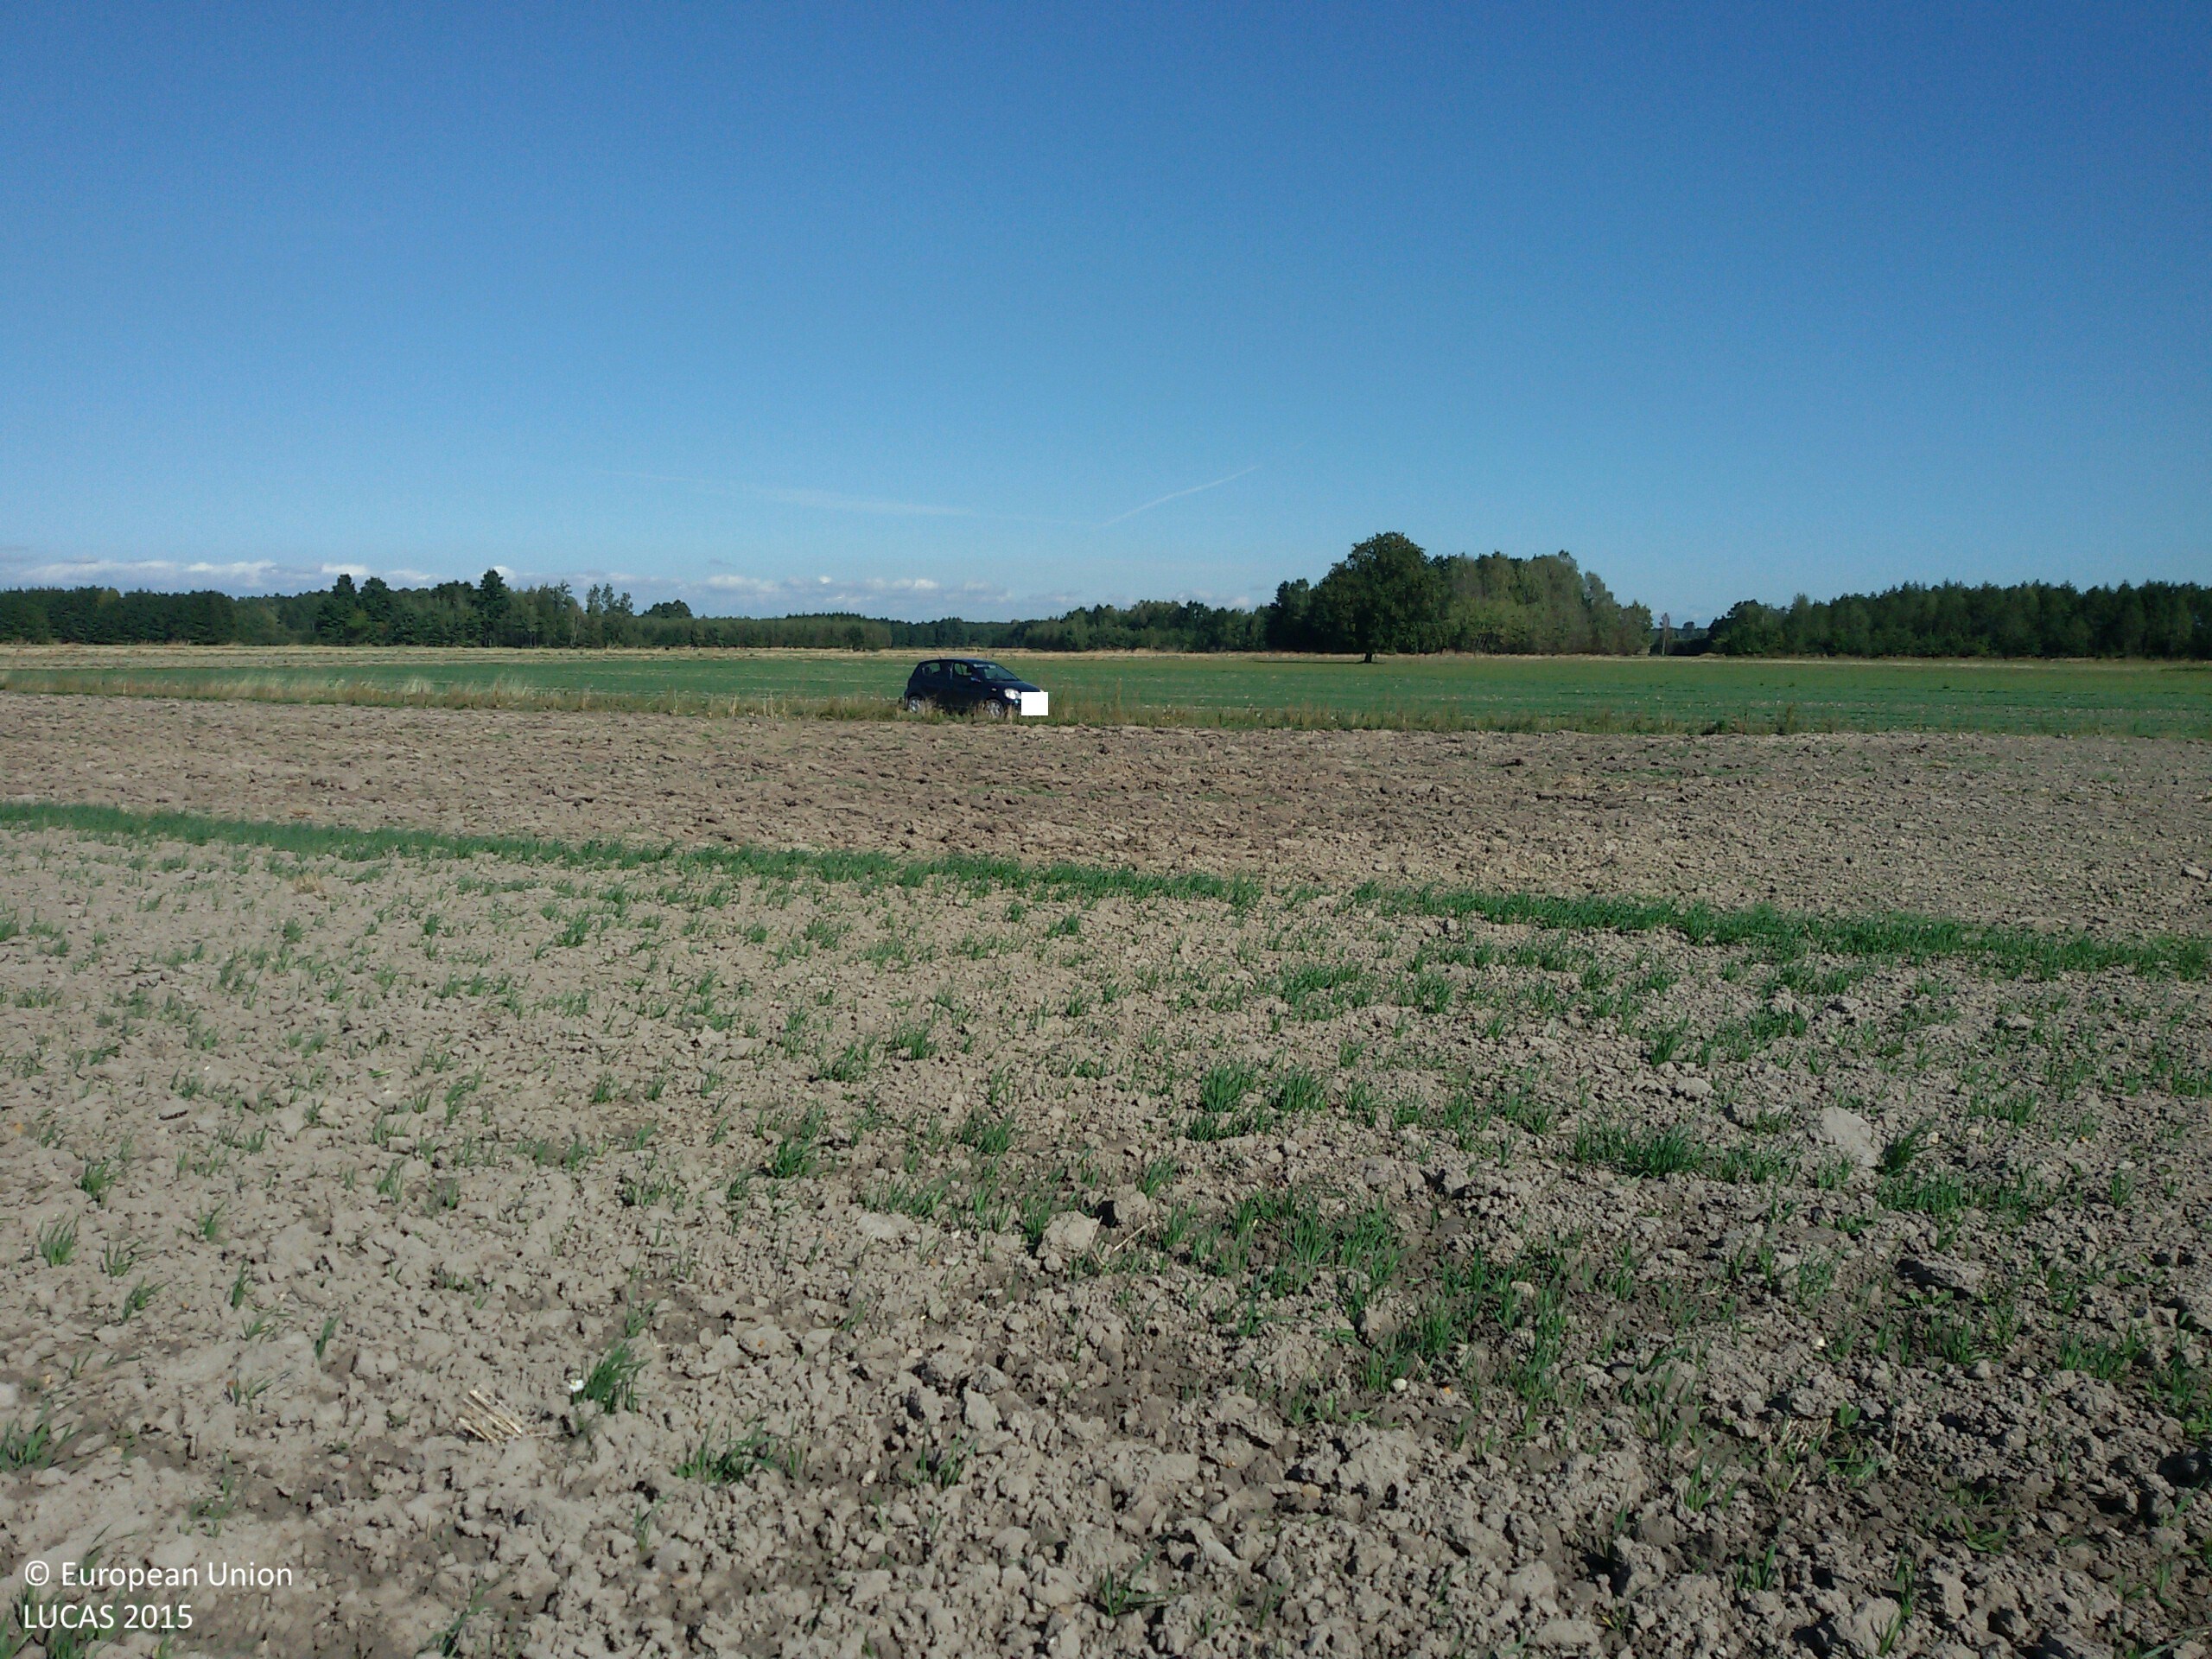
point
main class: Cropland
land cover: Common wheat
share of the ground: < 10 %
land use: Agriculture (excluding fallow land and kitchen gardens)
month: September
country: PL
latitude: 51.0769
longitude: 19.6639
